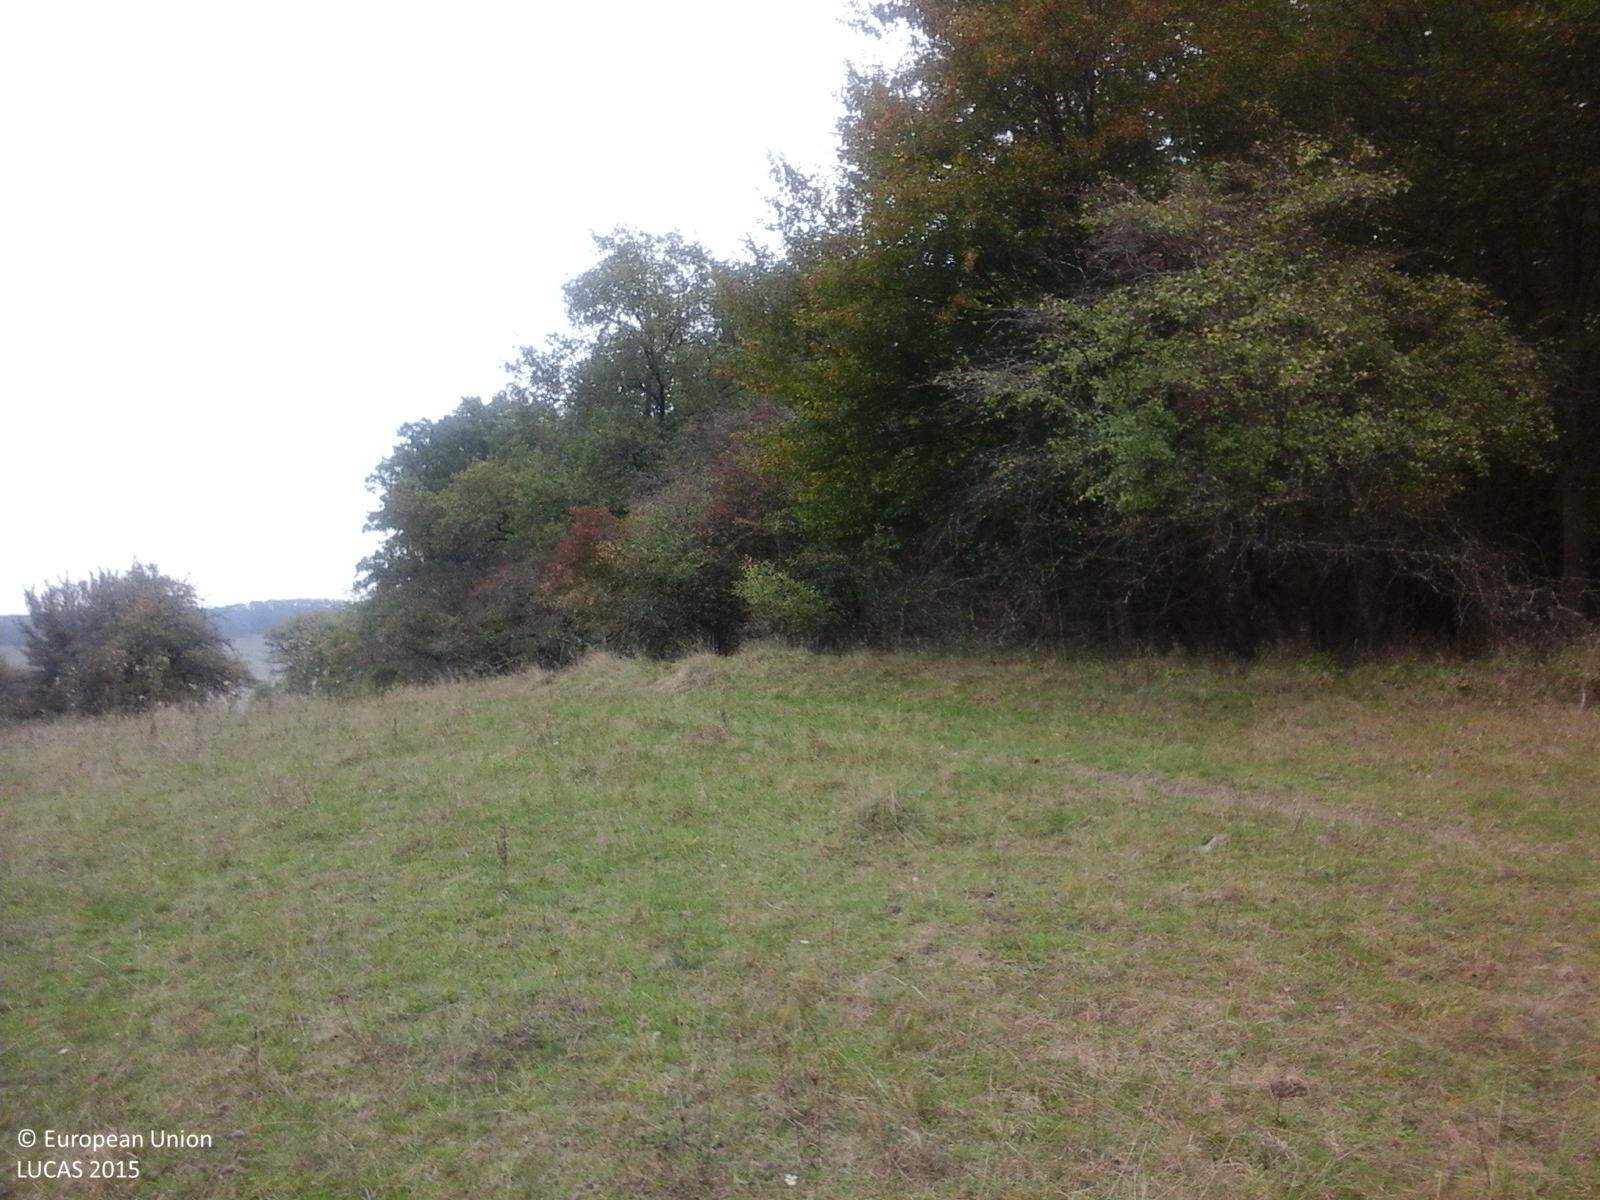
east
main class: Grassland
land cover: Grassland without tree/shrub cover
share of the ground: > 75 %
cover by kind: herbaceous plants 100 %
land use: Agriculture (excluding fallow land and kitchen gardens)
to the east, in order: Grassland without tree/shrub cover; Tracks; Broadleaved woodland
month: October
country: RO
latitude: 46.0965
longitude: 25.2203
